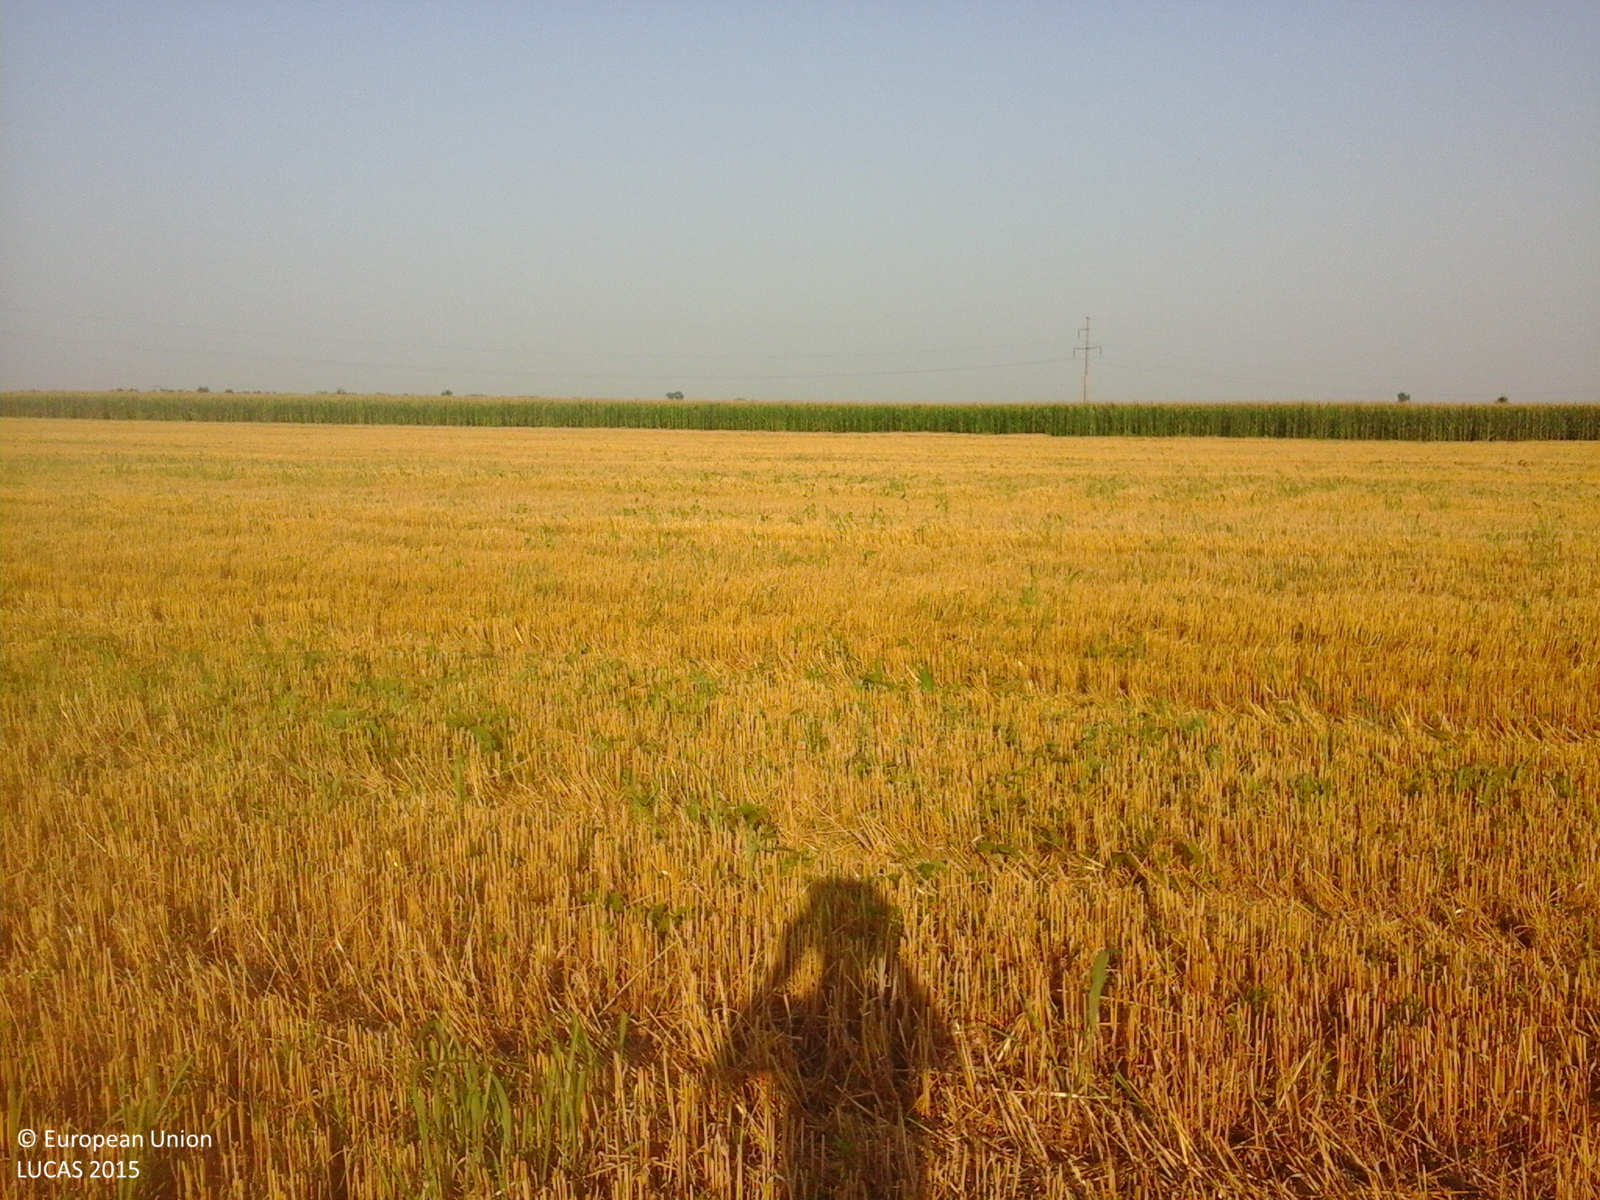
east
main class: Cropland
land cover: Common wheat
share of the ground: 25 - 50 %
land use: Agriculture (excluding fallow land and kitchen gardens)
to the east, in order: Common wheat; Maize; Electric lines; Maize
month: July
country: RO
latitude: 44.6137
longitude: 25.5820
